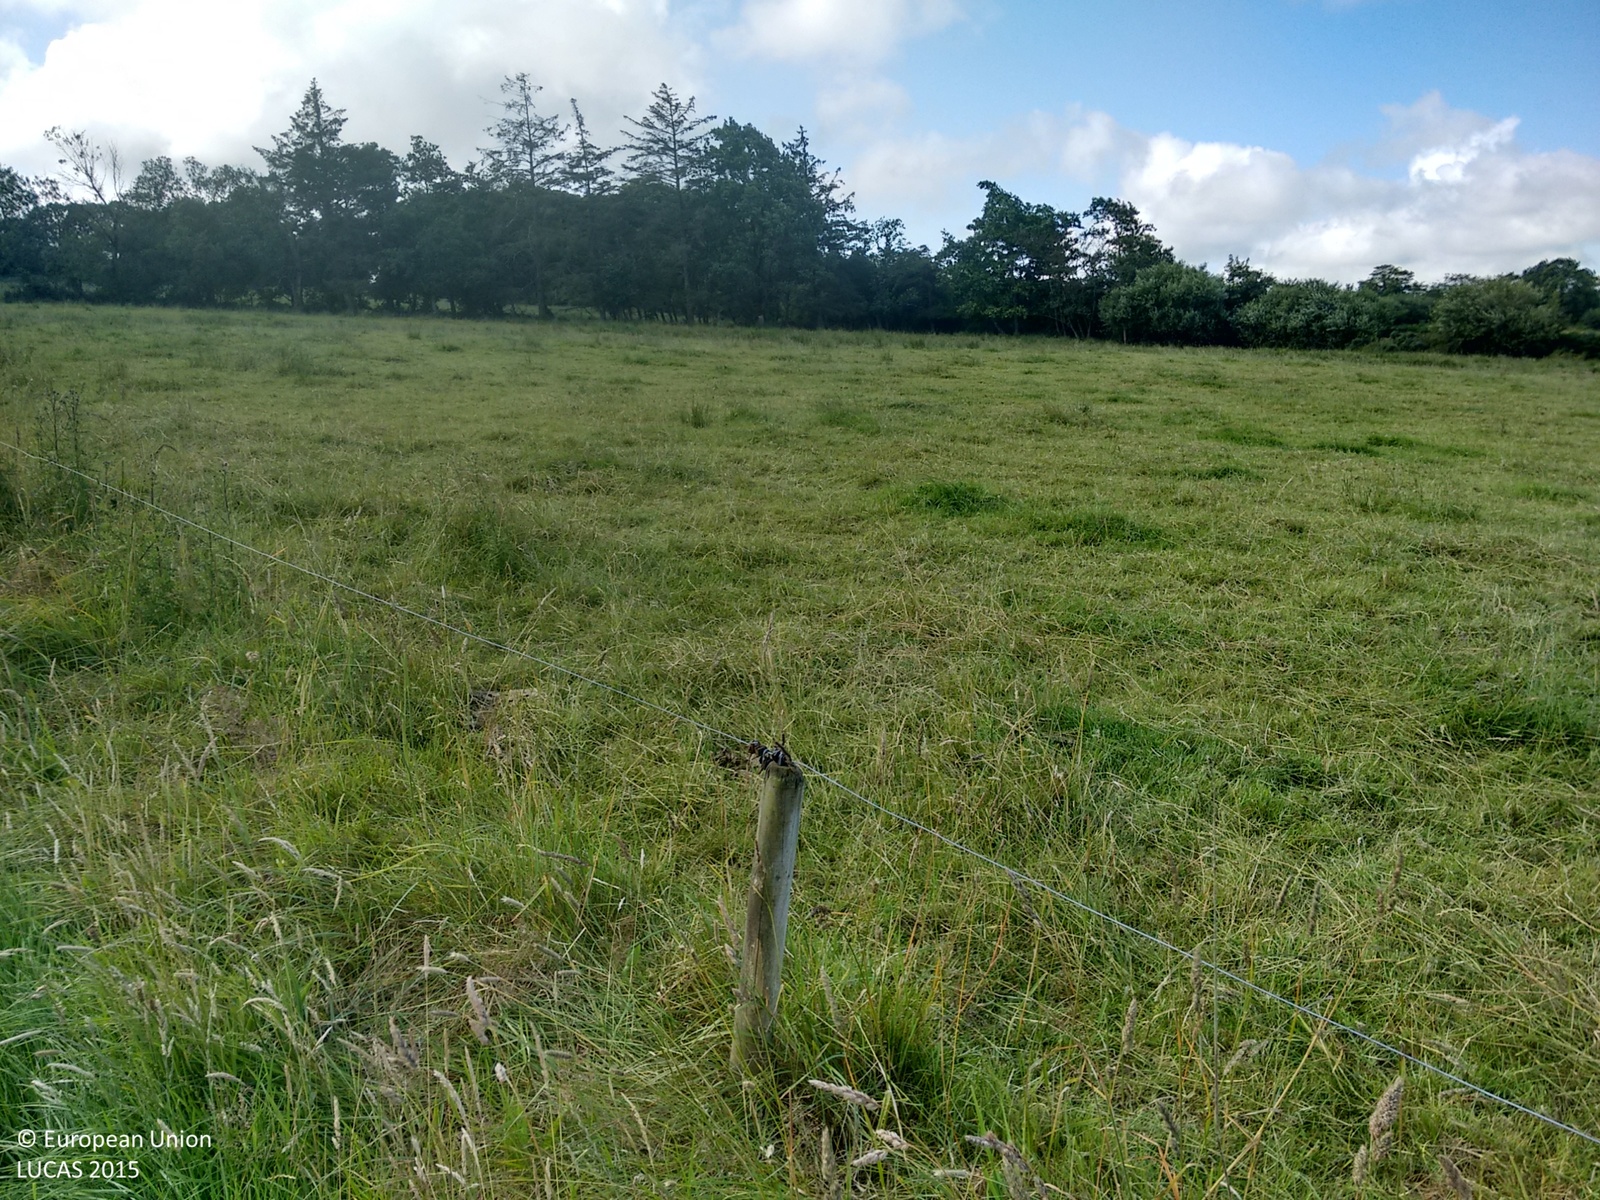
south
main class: Grassland
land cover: Grassland without tree/shrub cover
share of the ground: > 75 %
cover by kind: herbaceous plants 100 %
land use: Agriculture (excluding fallow land and kitchen gardens)
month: July
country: IE
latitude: 52.2123
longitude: -8.8679
